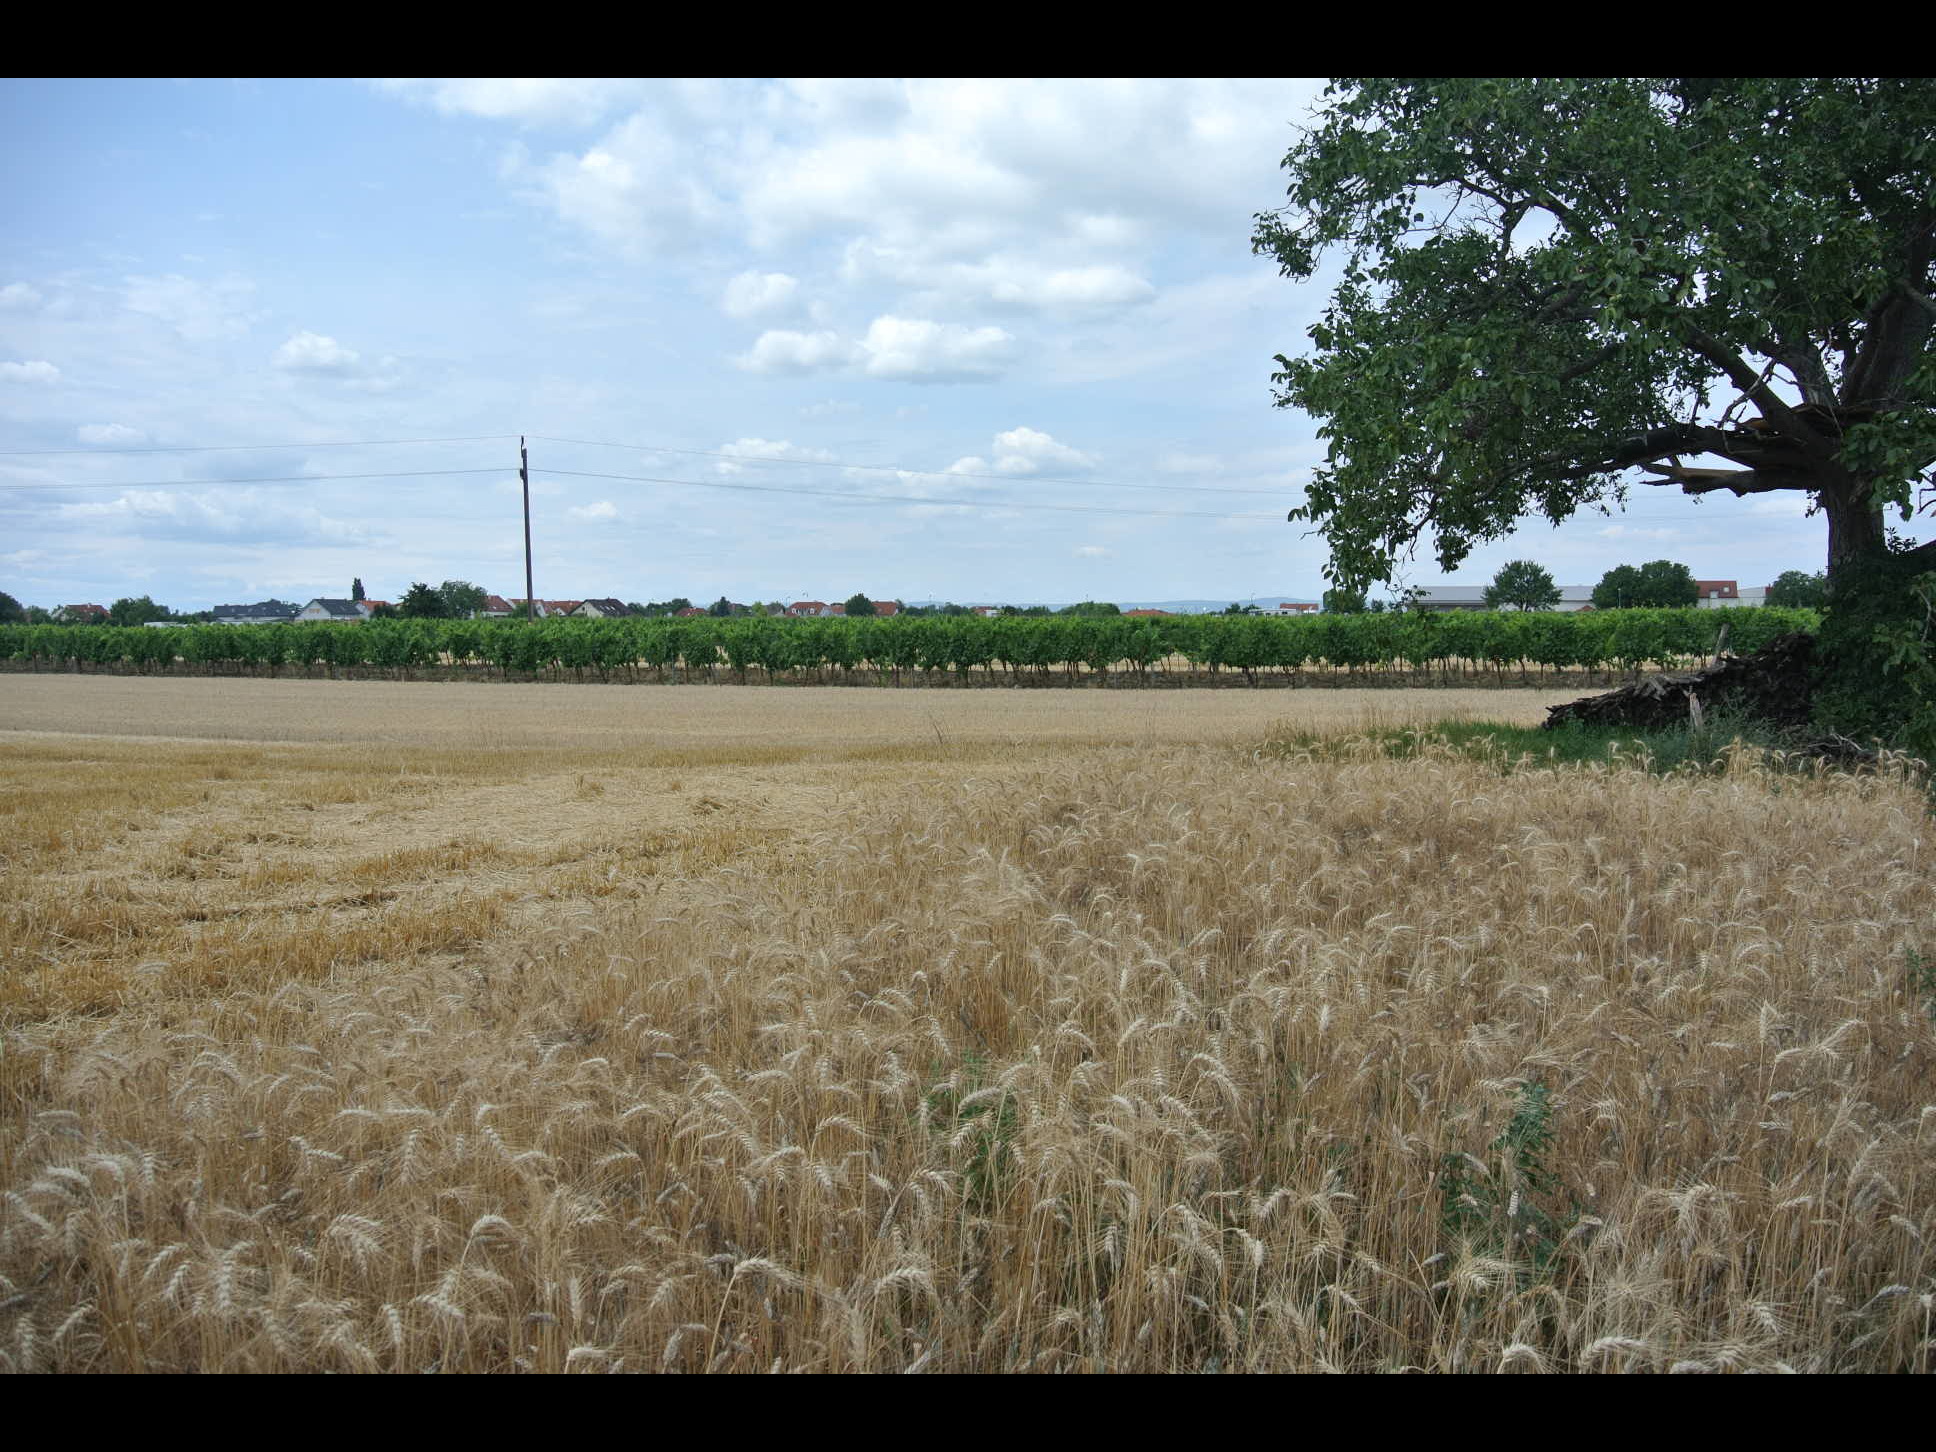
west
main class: Cropland
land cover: Durum wheat
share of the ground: > 75 %
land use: Agriculture (excluding fallow land and kitchen gardens)
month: July
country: AT
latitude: 47.8488
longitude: 16.8348
